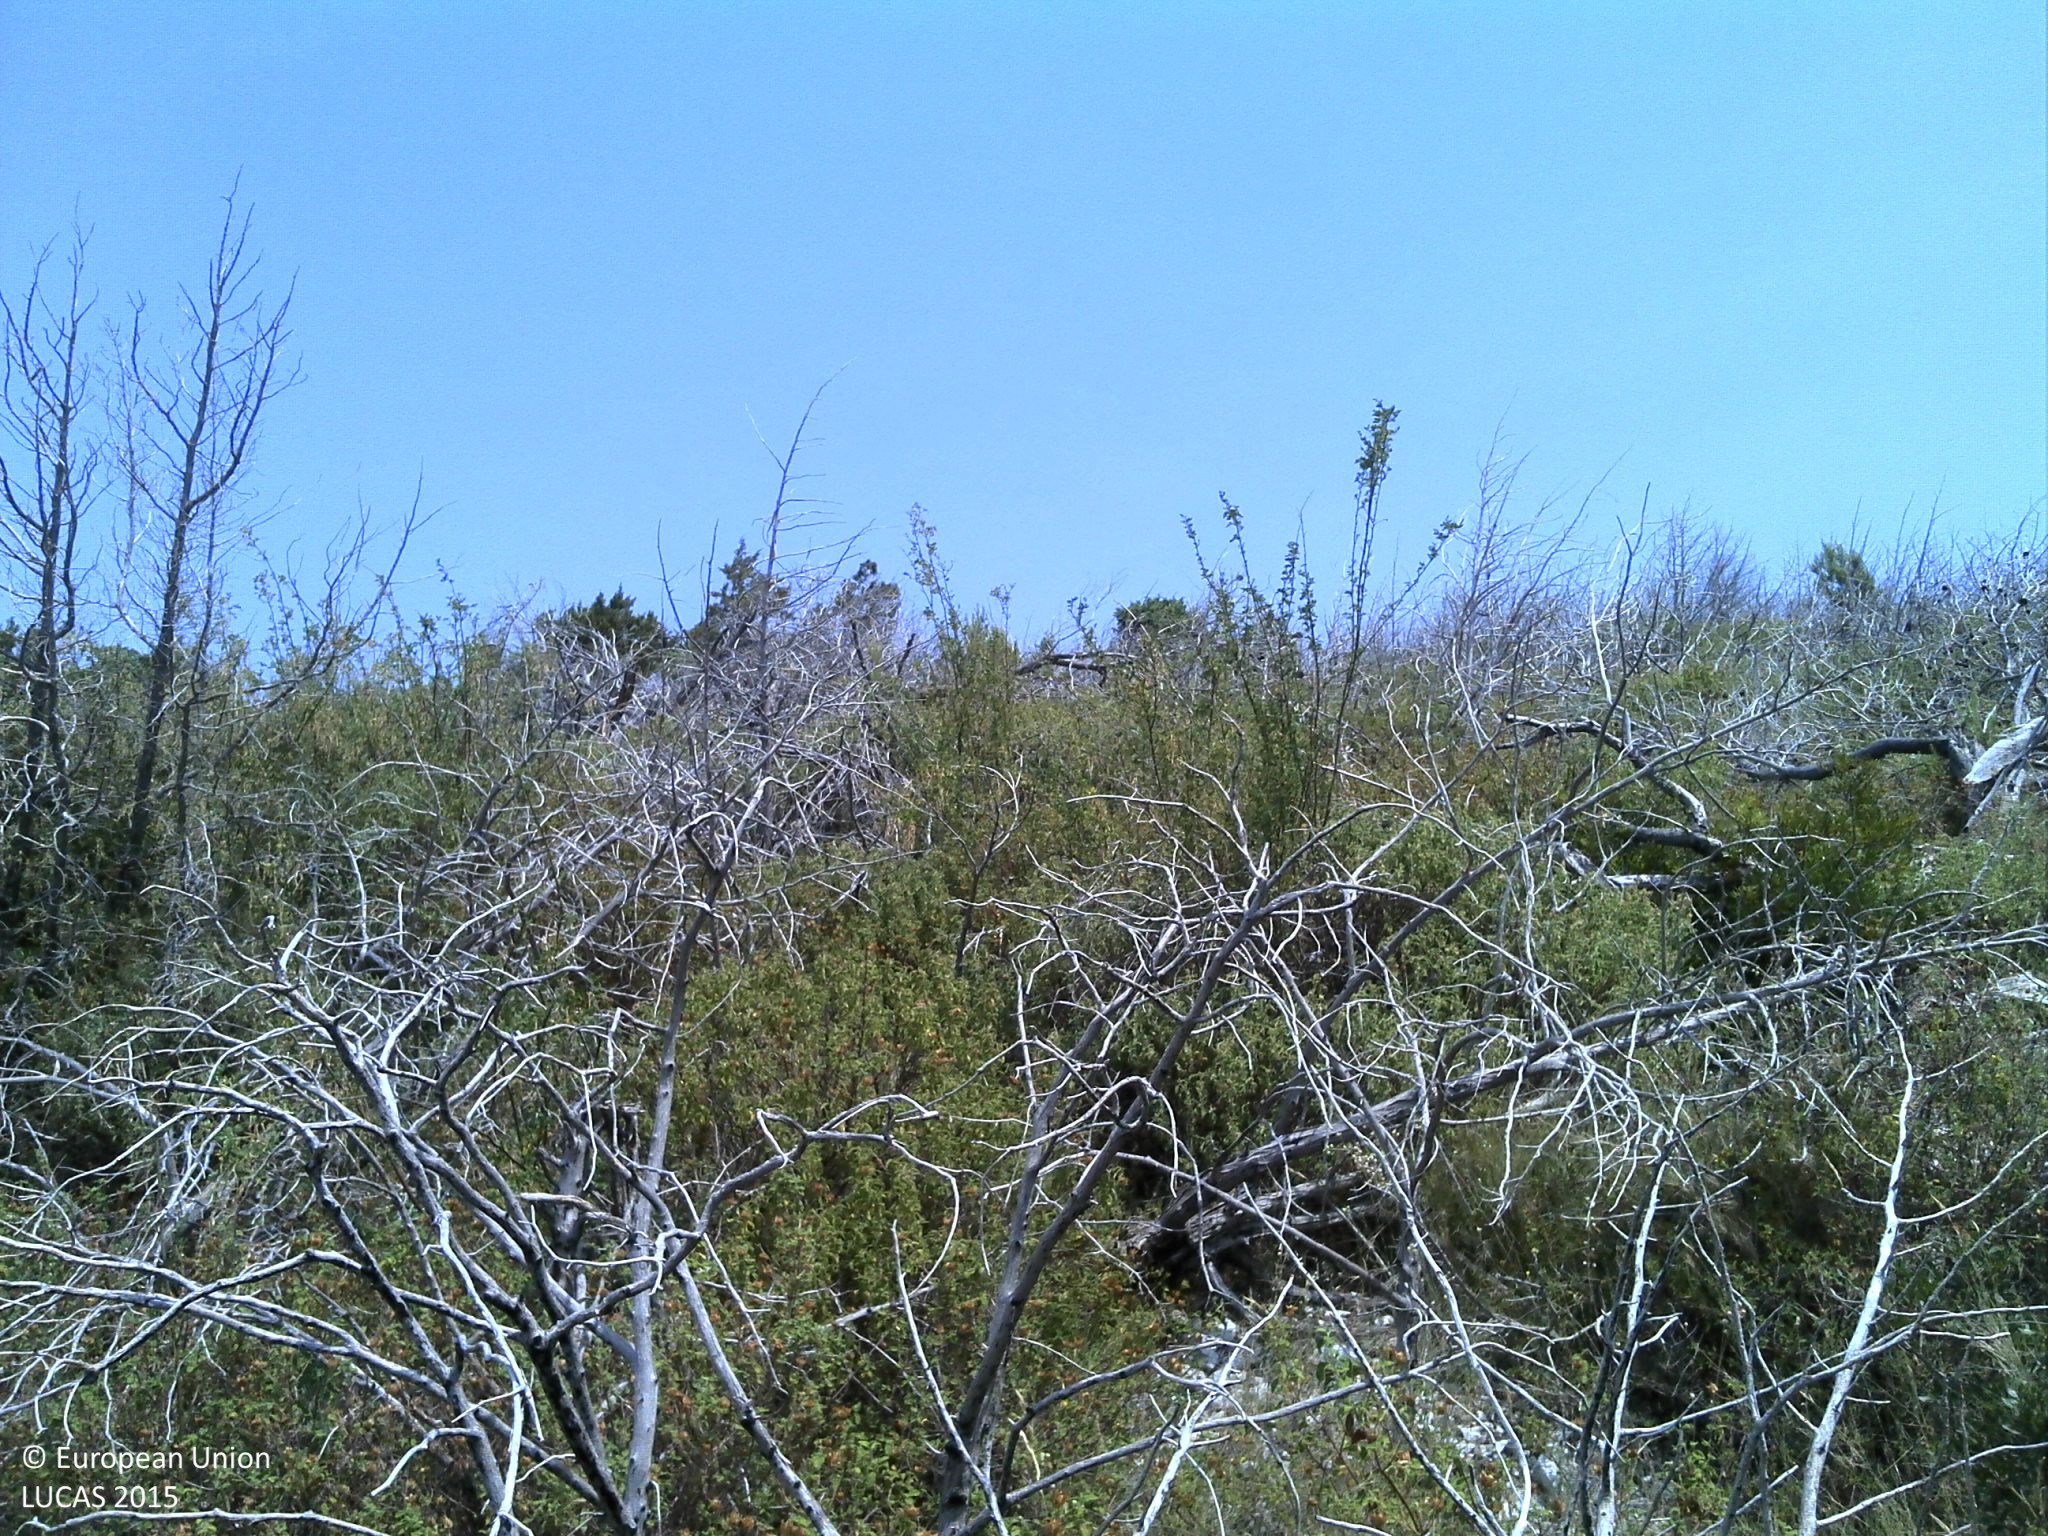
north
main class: Shrubland
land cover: Shrubland with sparse tree cover
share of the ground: 25 - 50 %
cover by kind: shrubs 35 %, herbaceous plants 30 %, consolidated bare surface 20 %, unconsolidated bare surface 10 %, broadleaved forest trees 5 %
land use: Abandoned areas
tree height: < 5 m
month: June
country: HR
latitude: 43.4891
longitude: 16.3092
